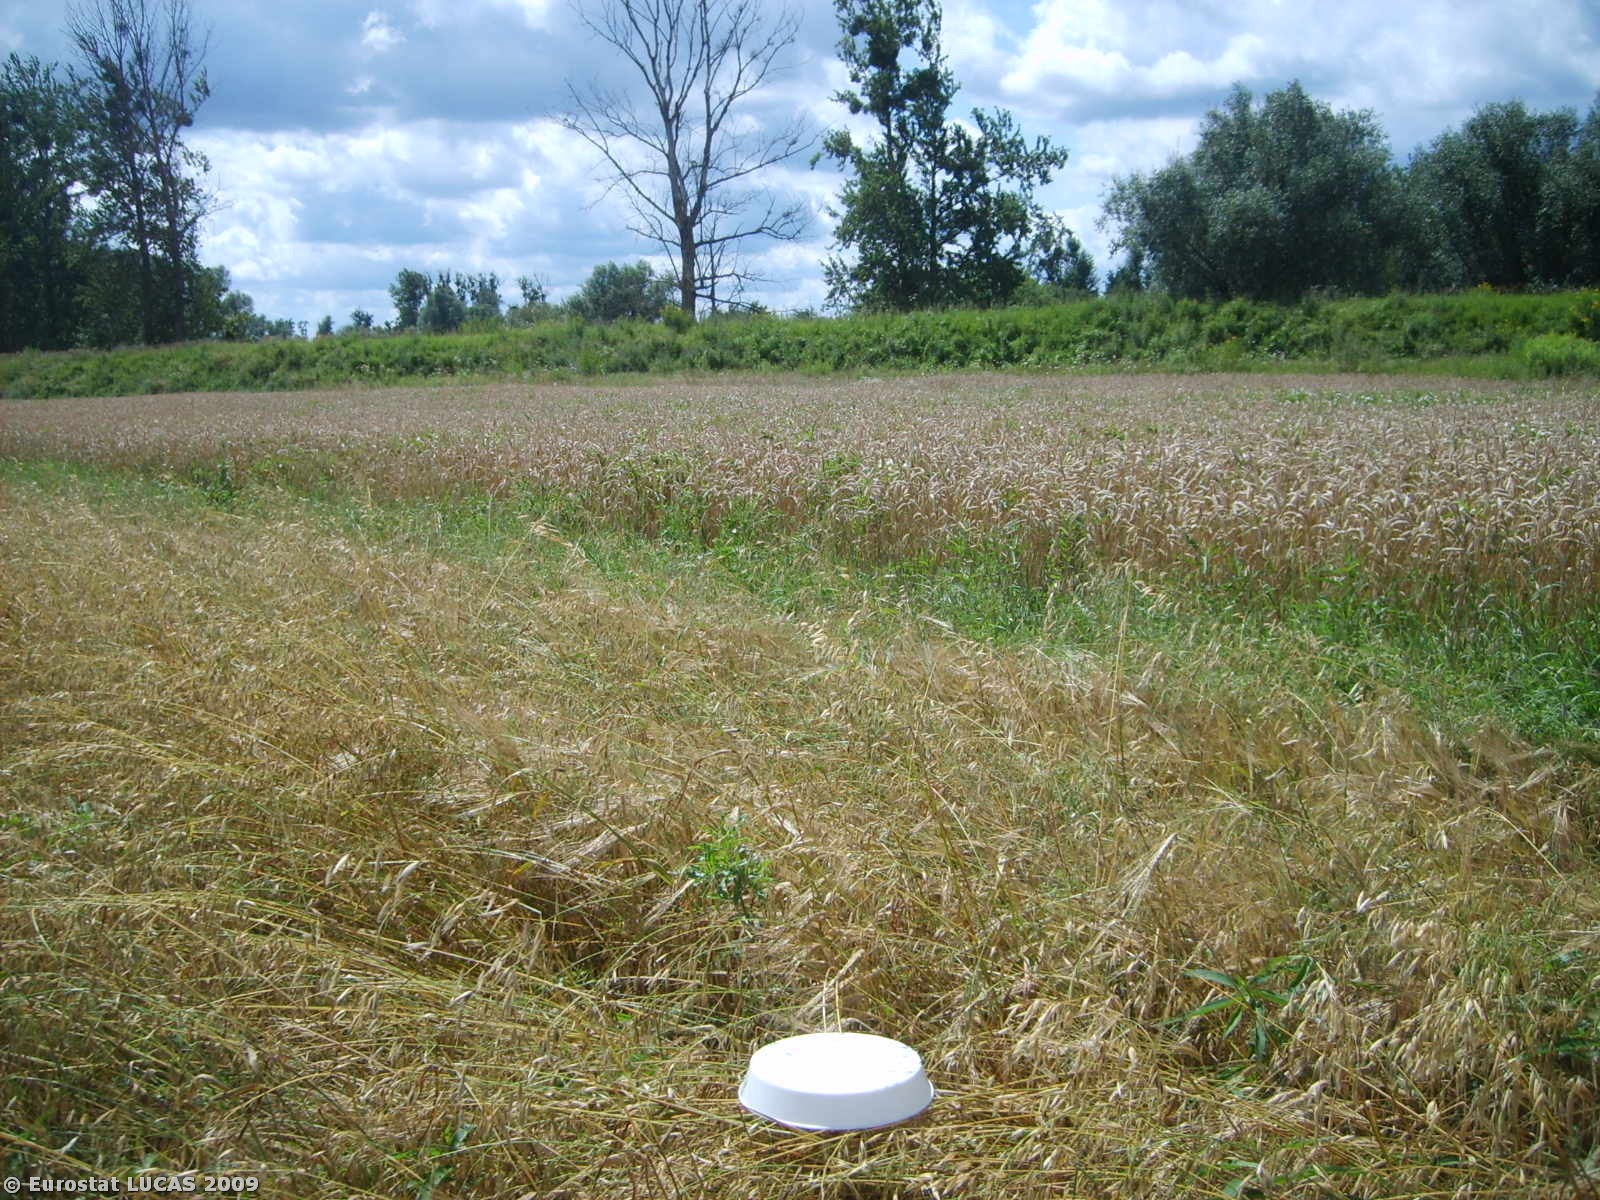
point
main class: Cropland
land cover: Mixed cereals for fodder
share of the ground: > 75 %
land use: Agriculture (excluding fallow land and kitchen gardens)
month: July
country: PL
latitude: 51.6516
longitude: 21.5131
